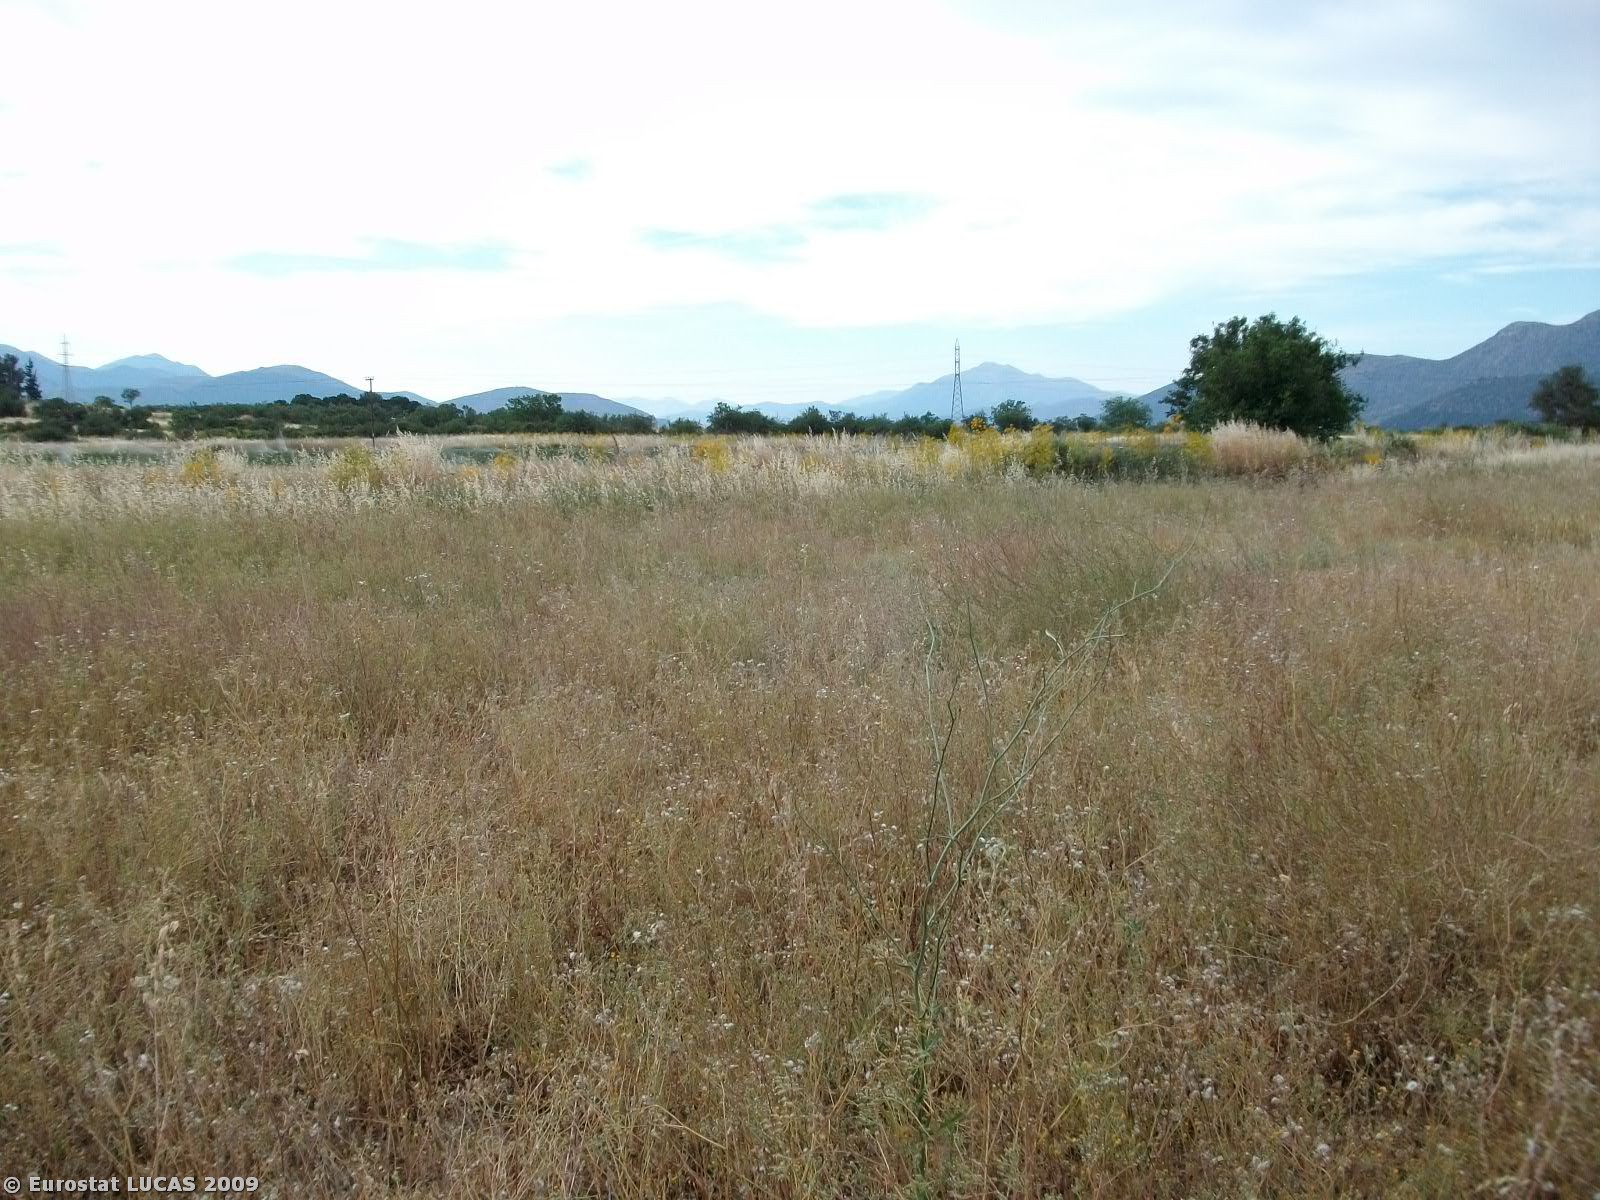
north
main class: Grassland
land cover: Spontaneously vegetated surfaces
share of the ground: > 75 %
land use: Fallow land
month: June
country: GR
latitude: 37.4778
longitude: 22.4347
